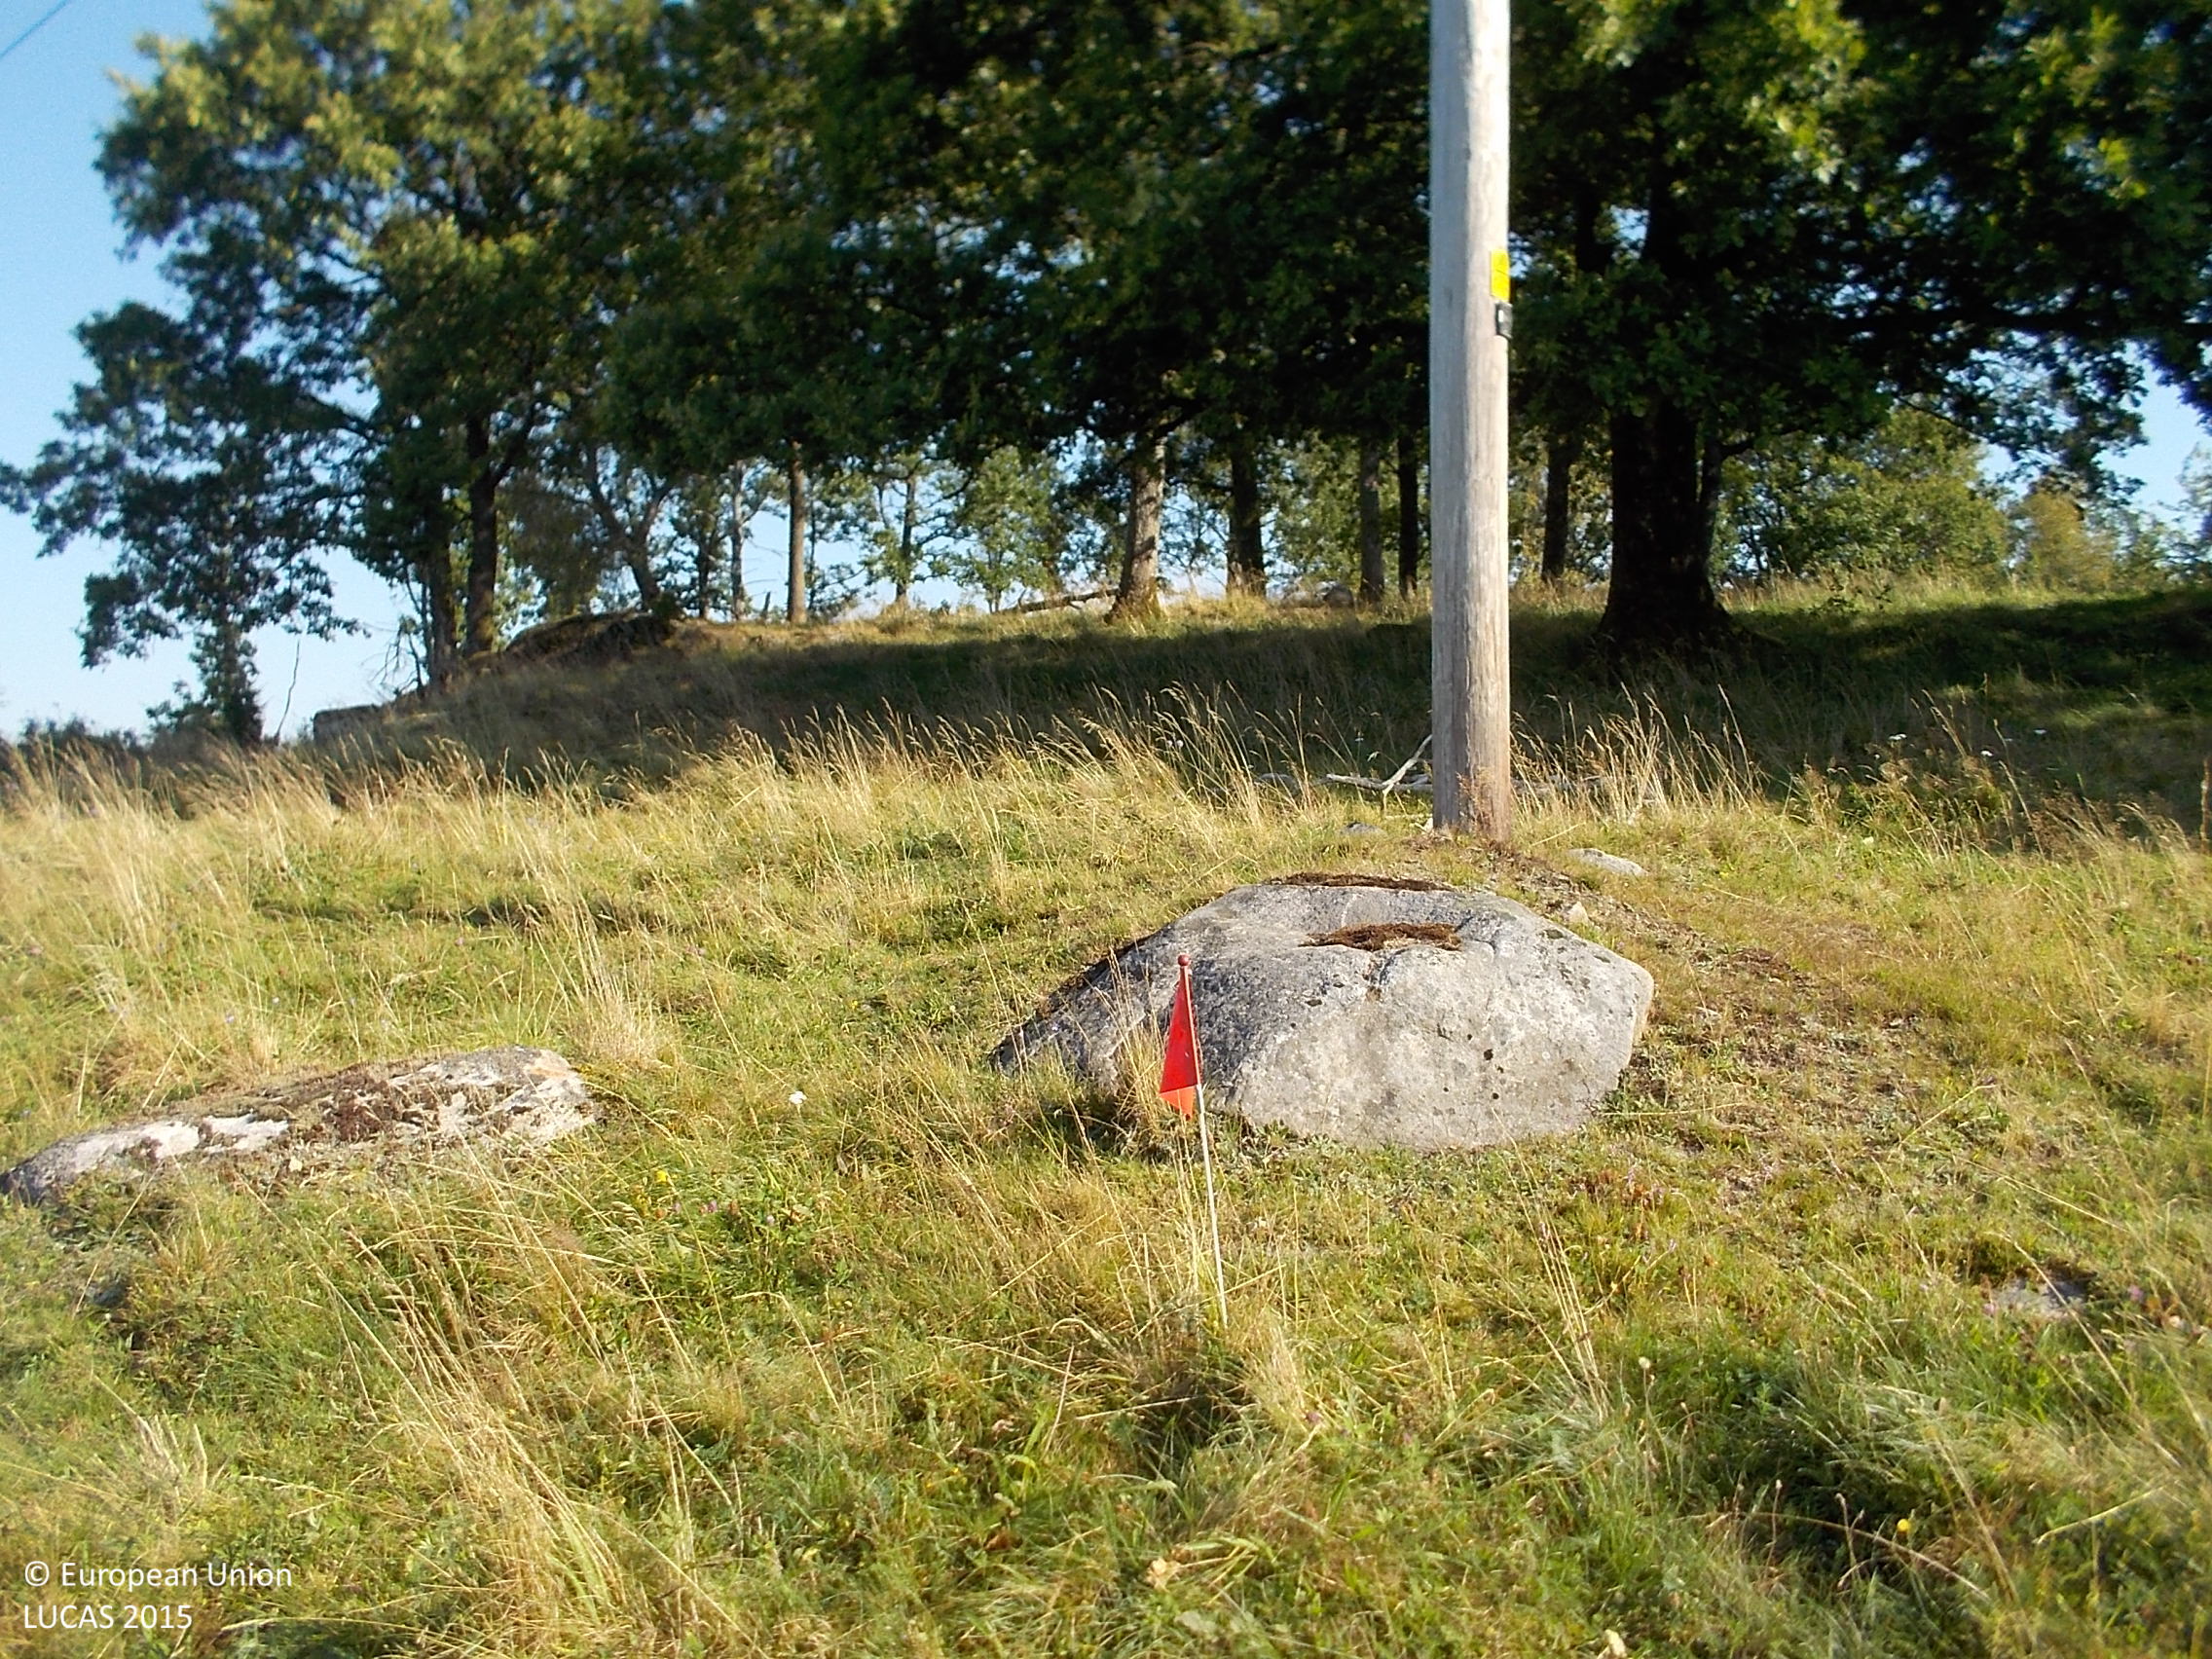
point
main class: Grassland
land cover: Grassland without tree/shrub cover
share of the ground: > 75 %
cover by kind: herbaceous plants 100 %
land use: Agriculture (excluding fallow land and kitchen gardens)
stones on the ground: < 10 %
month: August
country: SE
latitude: 57.4252
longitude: 13.2098
